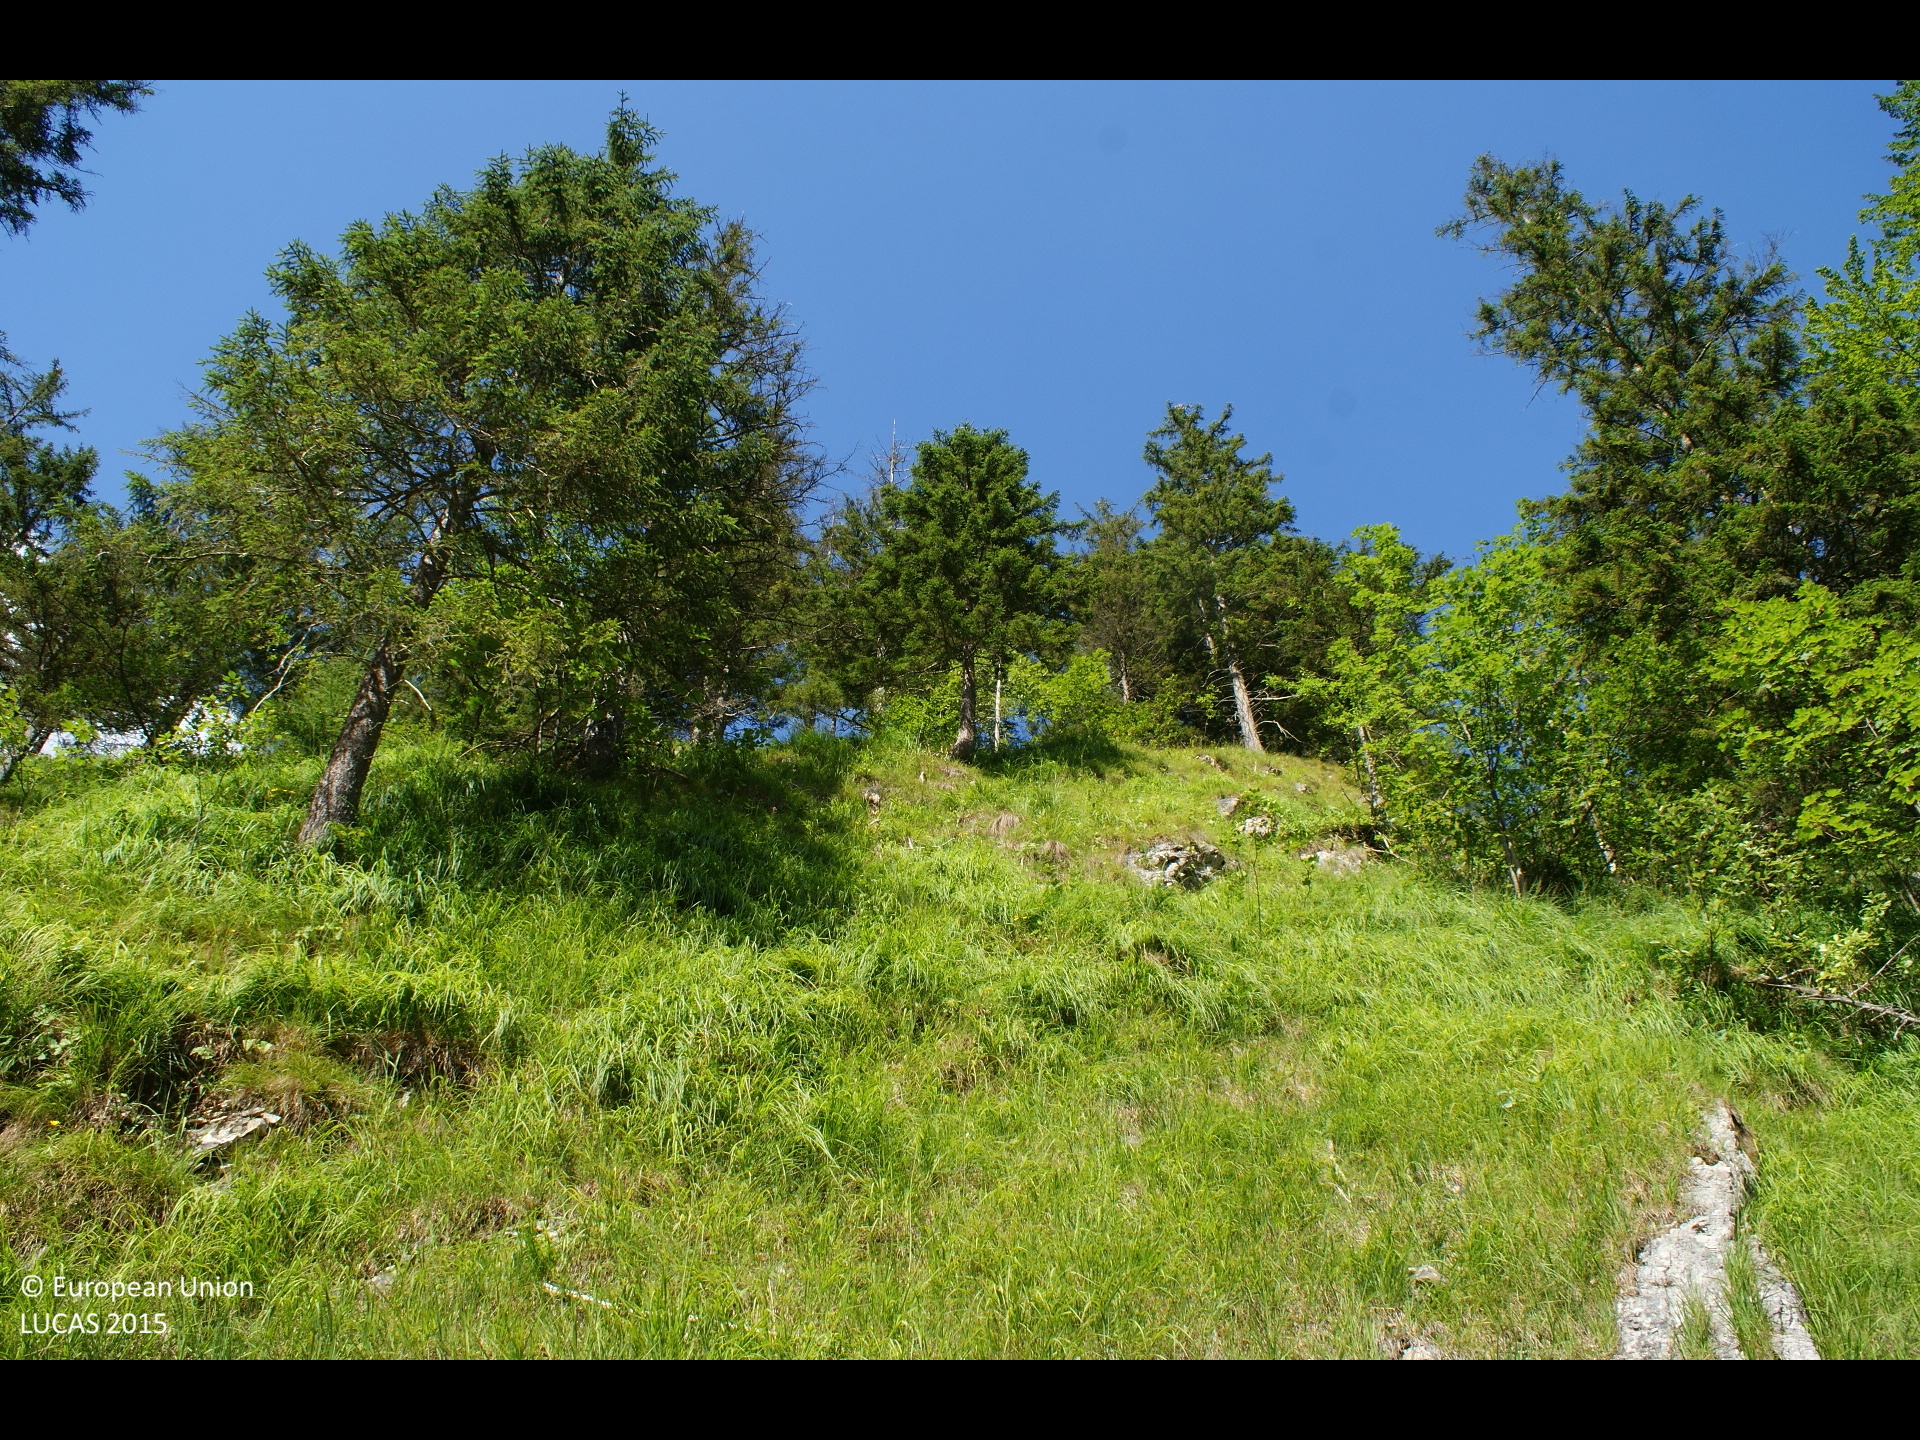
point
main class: Woodland
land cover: Spruce dominated mixed woodland
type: mesophytic deciduous forest
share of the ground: 50 - 75 %
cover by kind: coniferous forest trees 35 %, herbaceous plants 35 %, broadleaved forest trees 20 %, shrubs 5 %
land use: Forestry
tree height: > 5 m
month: July
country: AT
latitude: 47.7589
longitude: 14.7894
